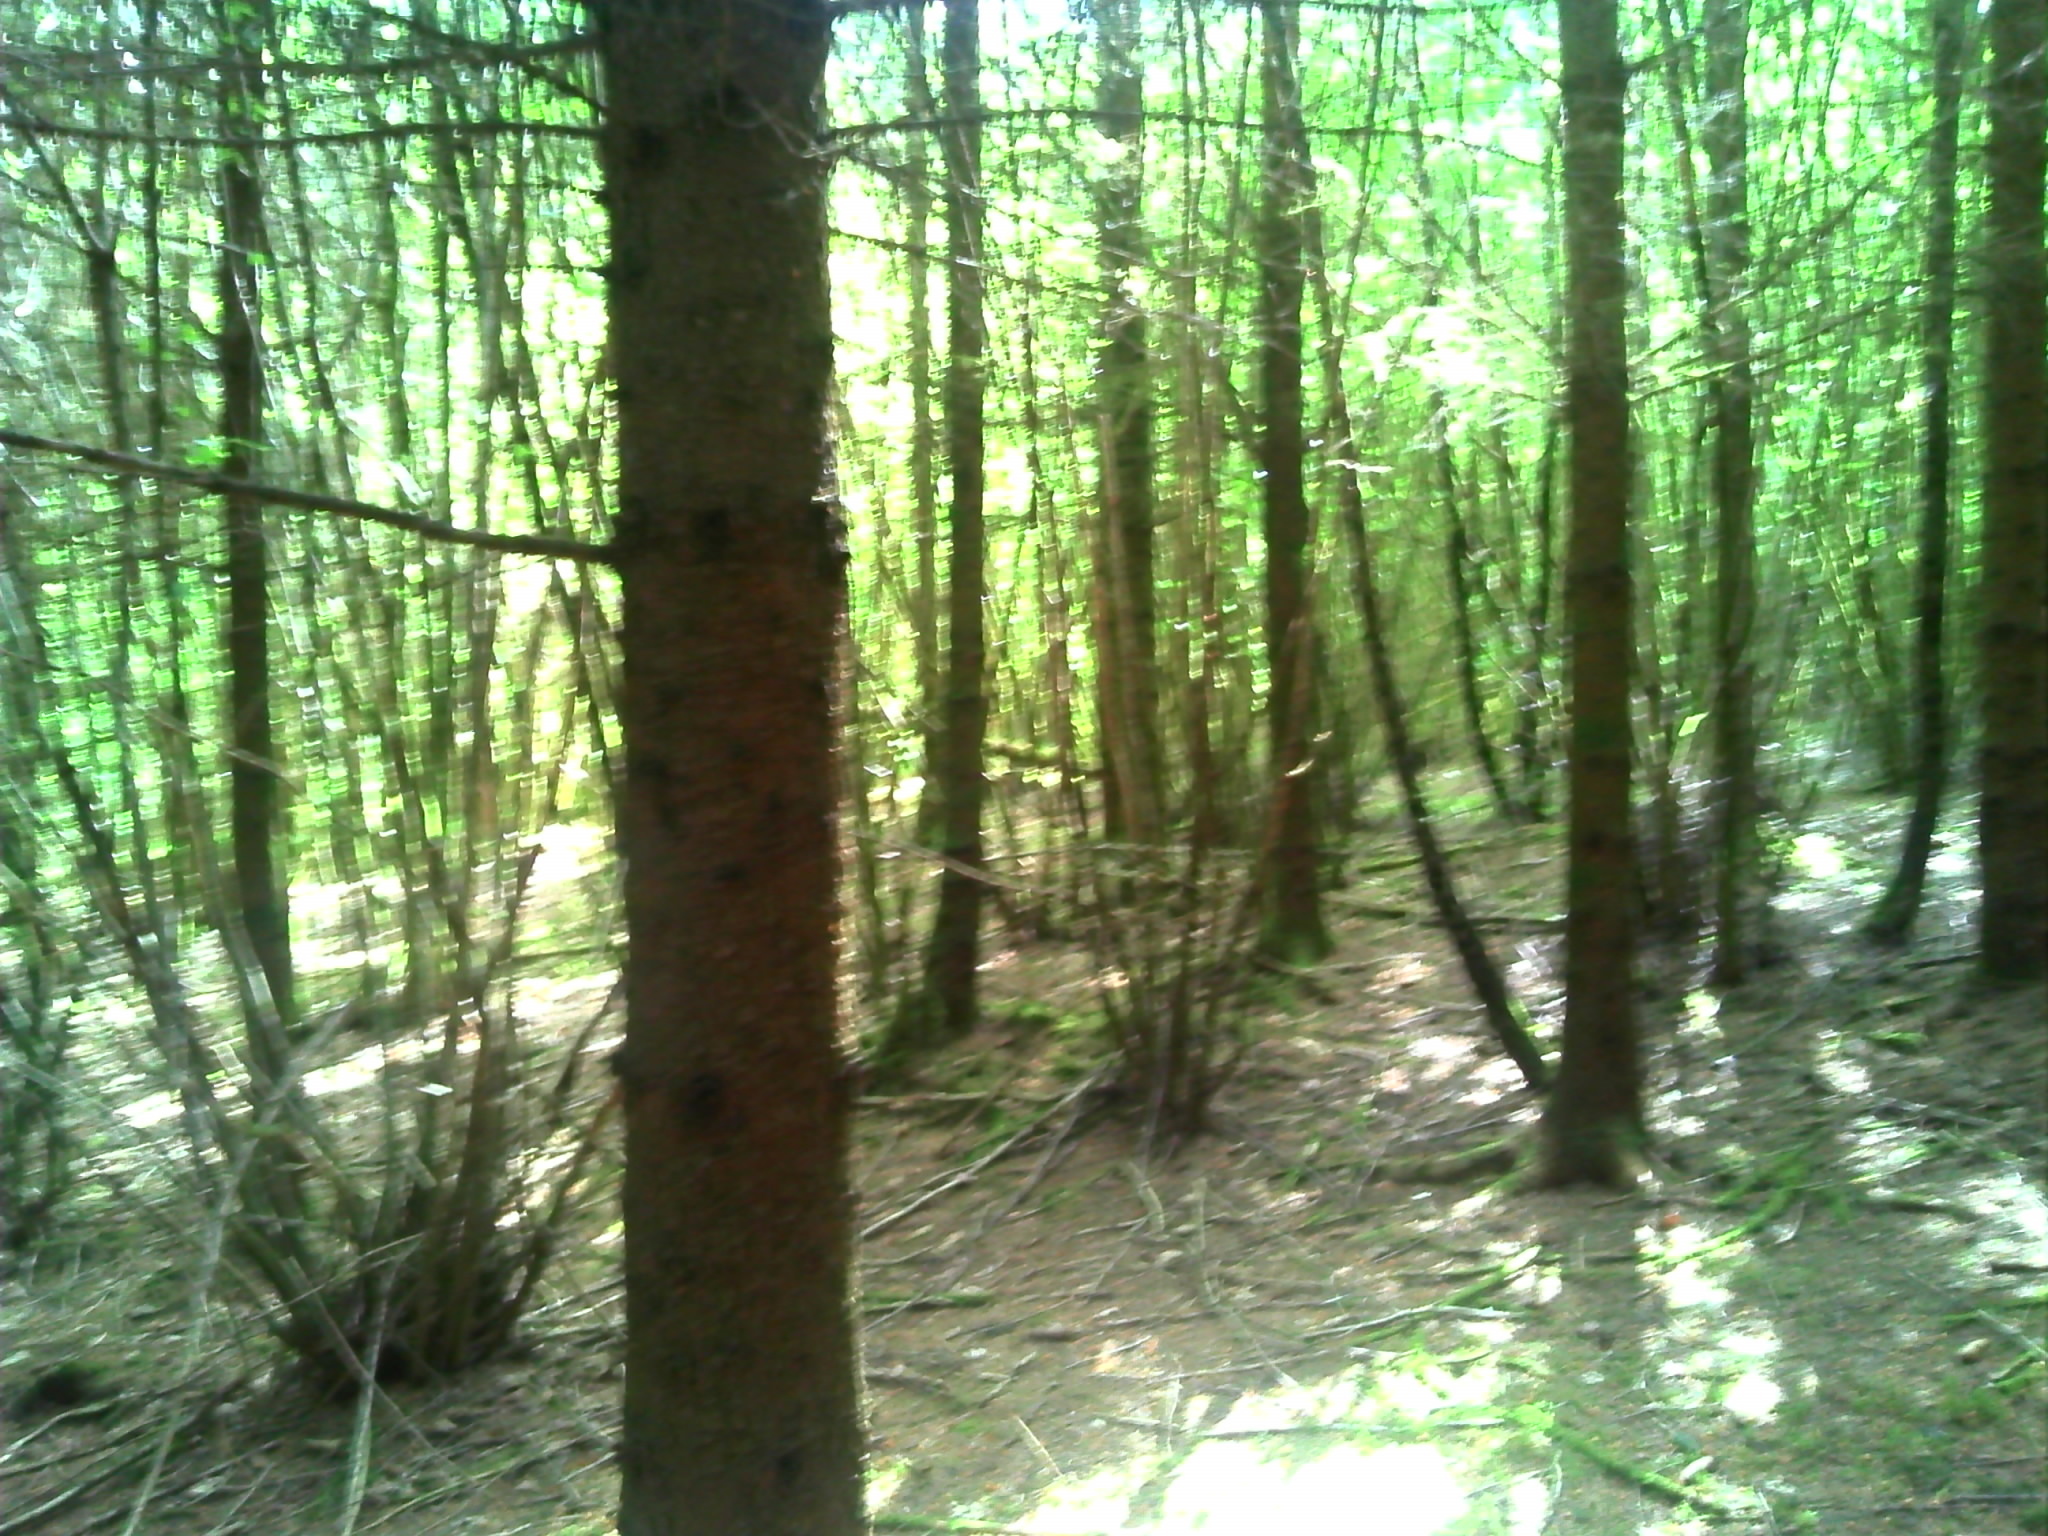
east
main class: Woodland
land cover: Spruce dominated coniferous woodland
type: exotic forest
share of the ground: > 75 %
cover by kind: coniferous forest trees 75 %, broadleaved forest trees 25 %
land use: Forestry
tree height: > 5 m
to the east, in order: Spruce dominated coniferous woodland; Fences; Grassland with sparse tree/shrub cover; Fences; Broadleaved woodland
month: May
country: LU
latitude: 49.9321
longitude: 5.9450
